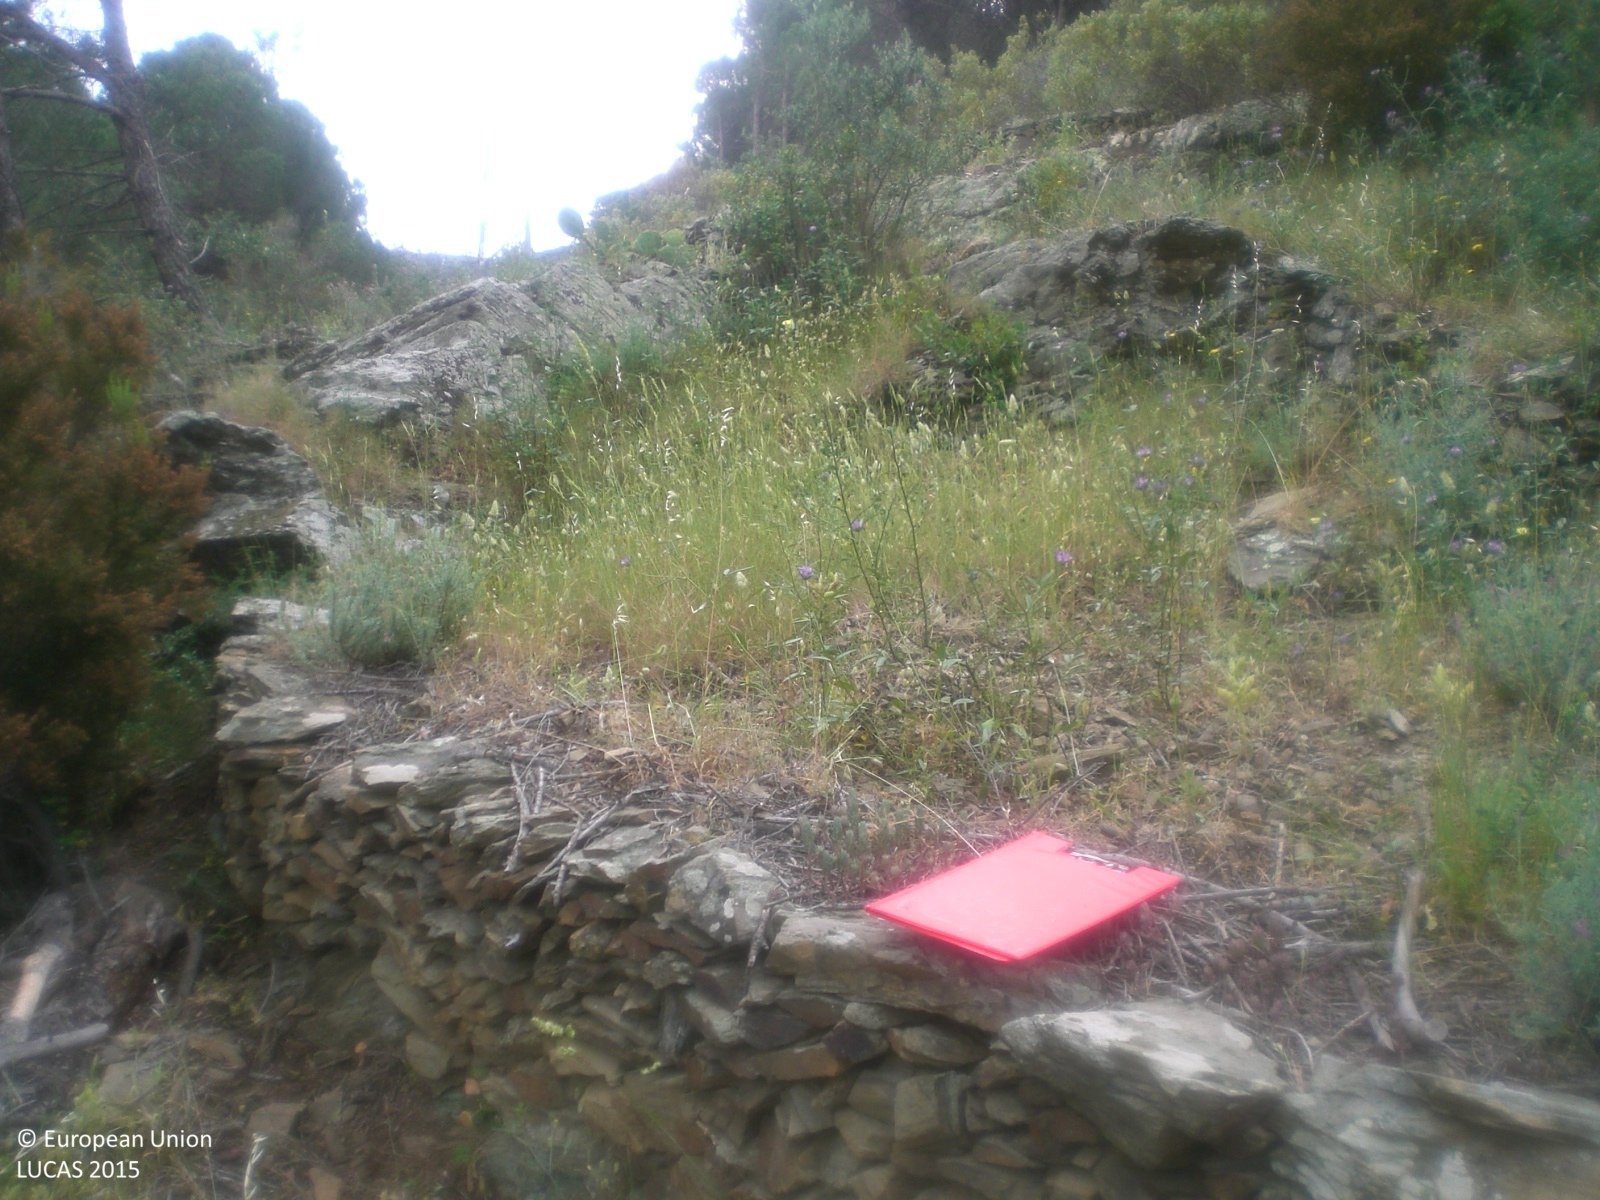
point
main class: Woodland
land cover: Pine dominated mixed woodland
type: coniferous forest of the mediterranean region
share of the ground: 10 - 25 %
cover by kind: herbaceous plants 30 %, coniferous forest trees 25 %, shrubs 25 %, broadleaved forest trees 10 %, consolidated bare surface 10 %
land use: Forestry
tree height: > 5 m
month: May
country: ES
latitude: 42.3171
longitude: 3.2075
